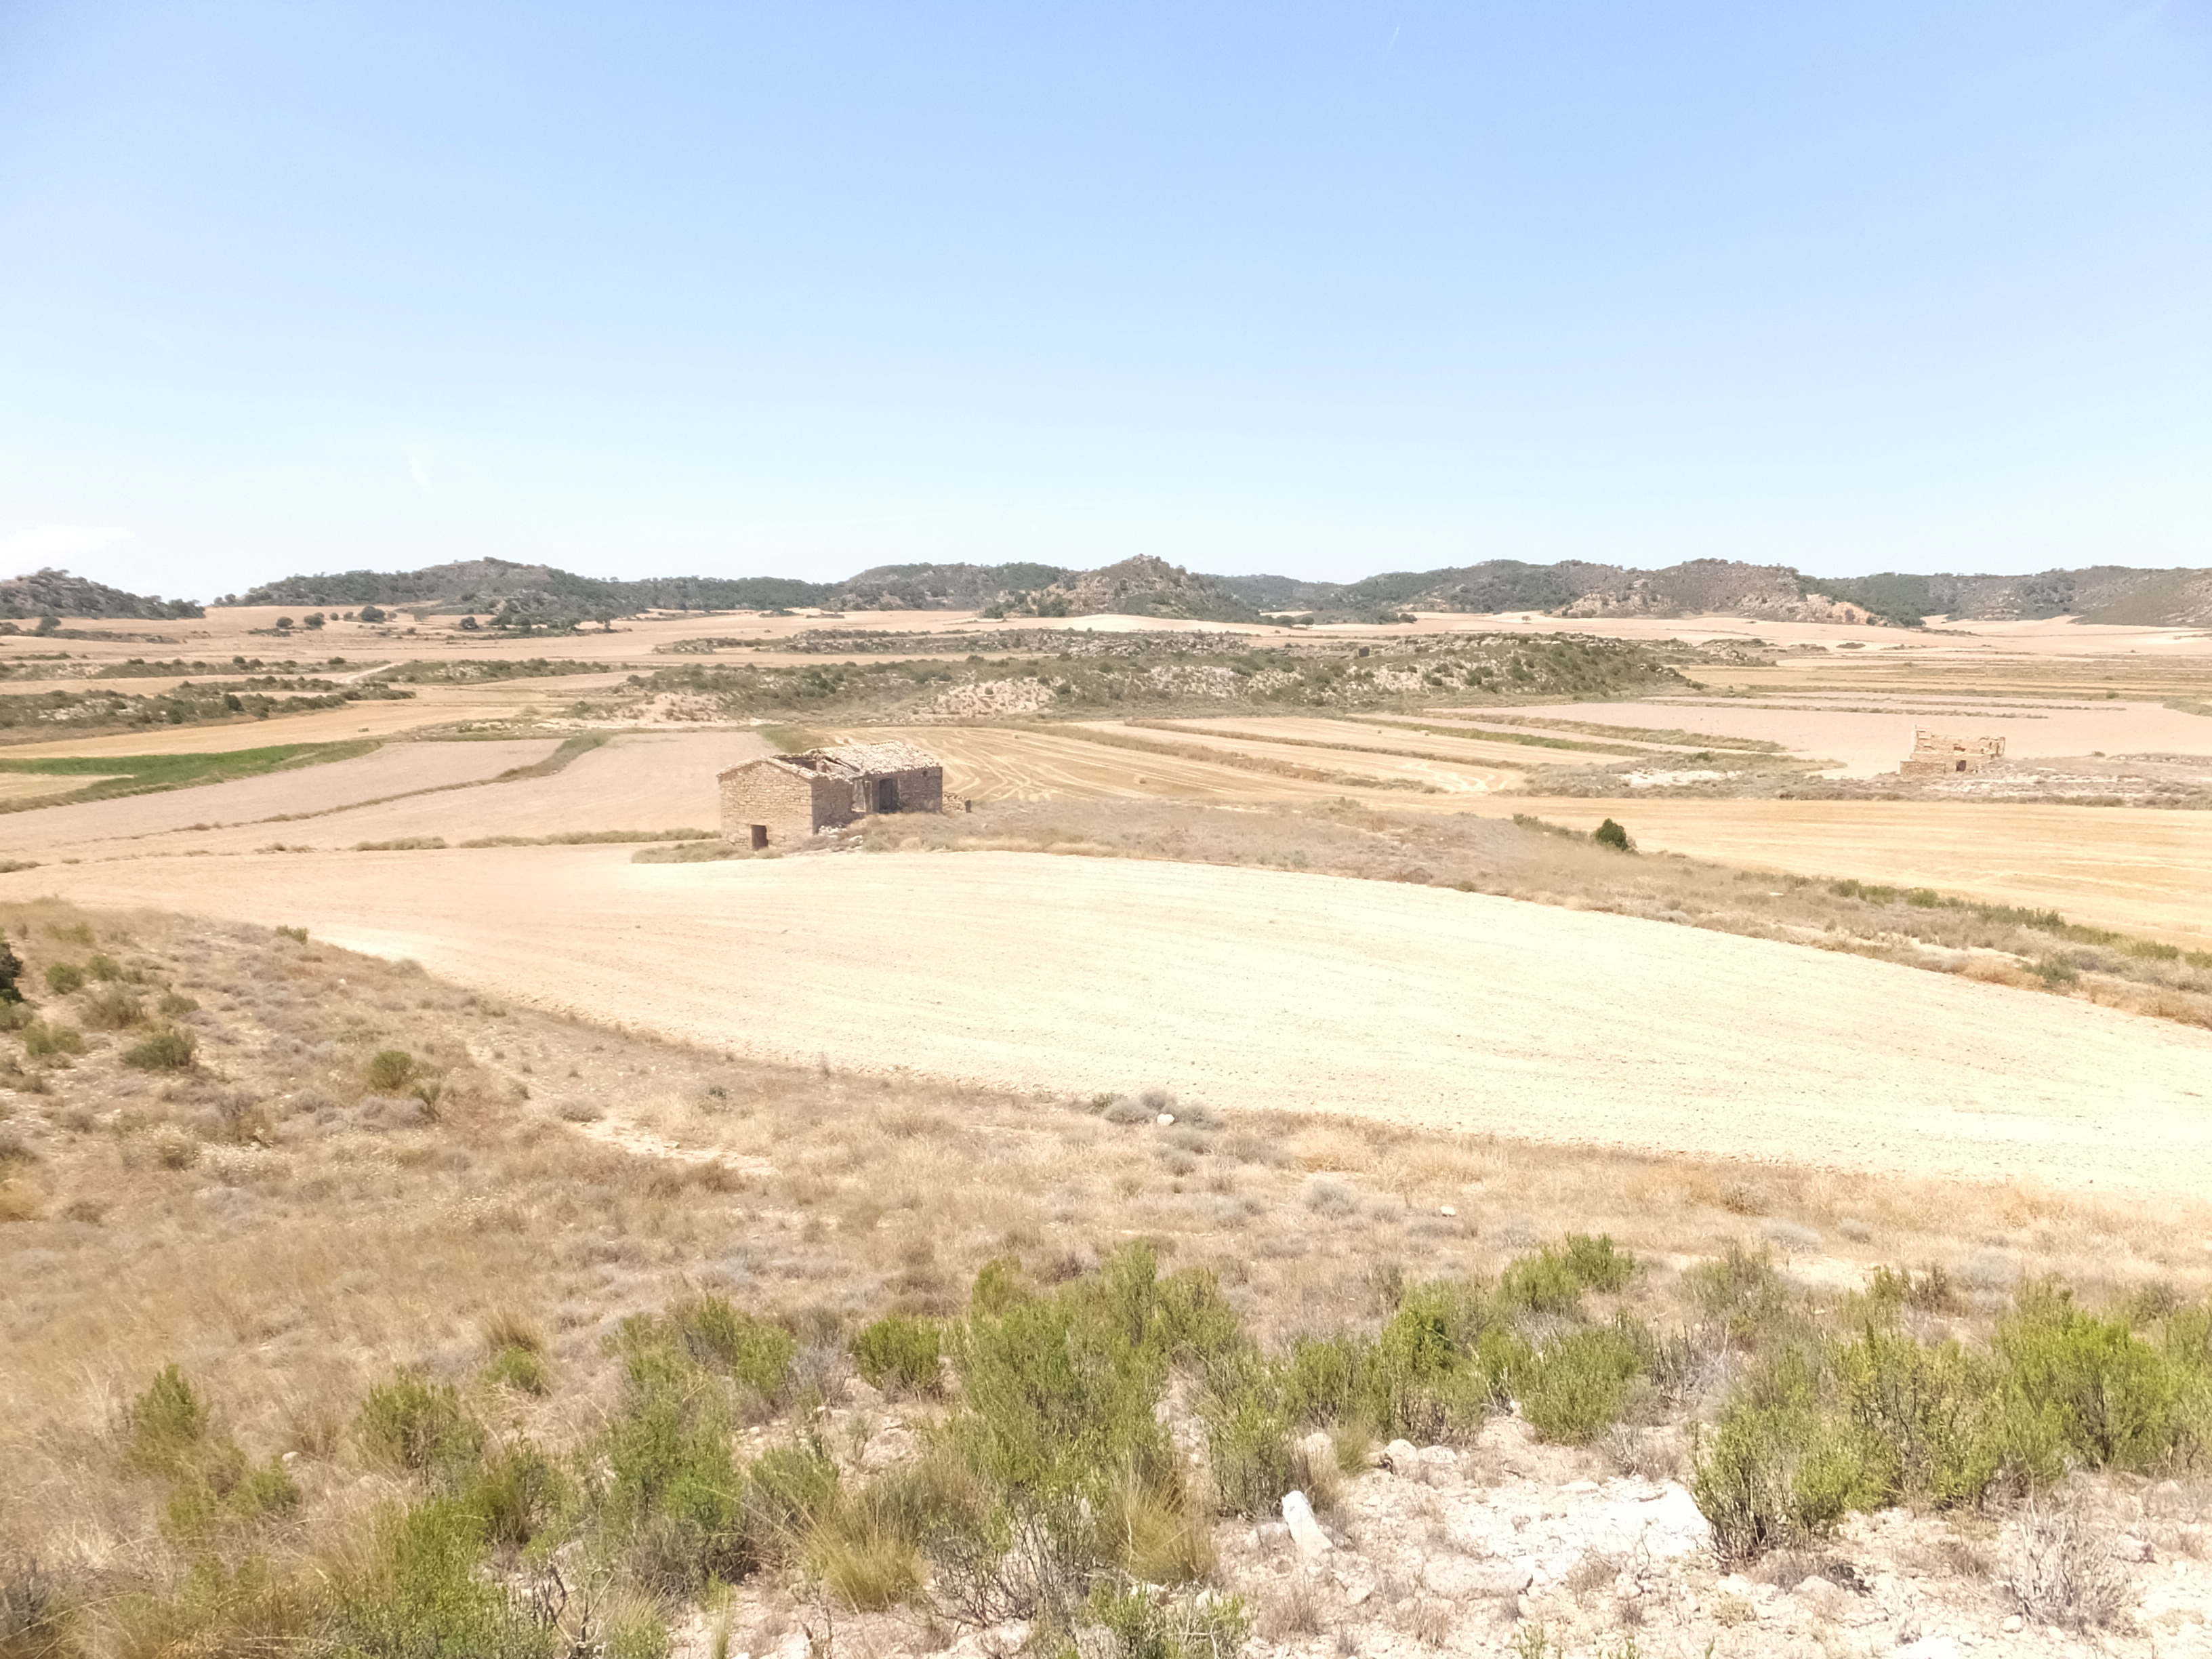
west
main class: Shrubland
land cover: Shrubland without tree cover
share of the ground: > 75 %
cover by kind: shrubs 40 %, herbaceous plants 40 %, consolidated bare surface 20 %
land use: Semi-natural and natural areas not in use
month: June
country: ES
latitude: 41.3258
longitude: -0.1334
